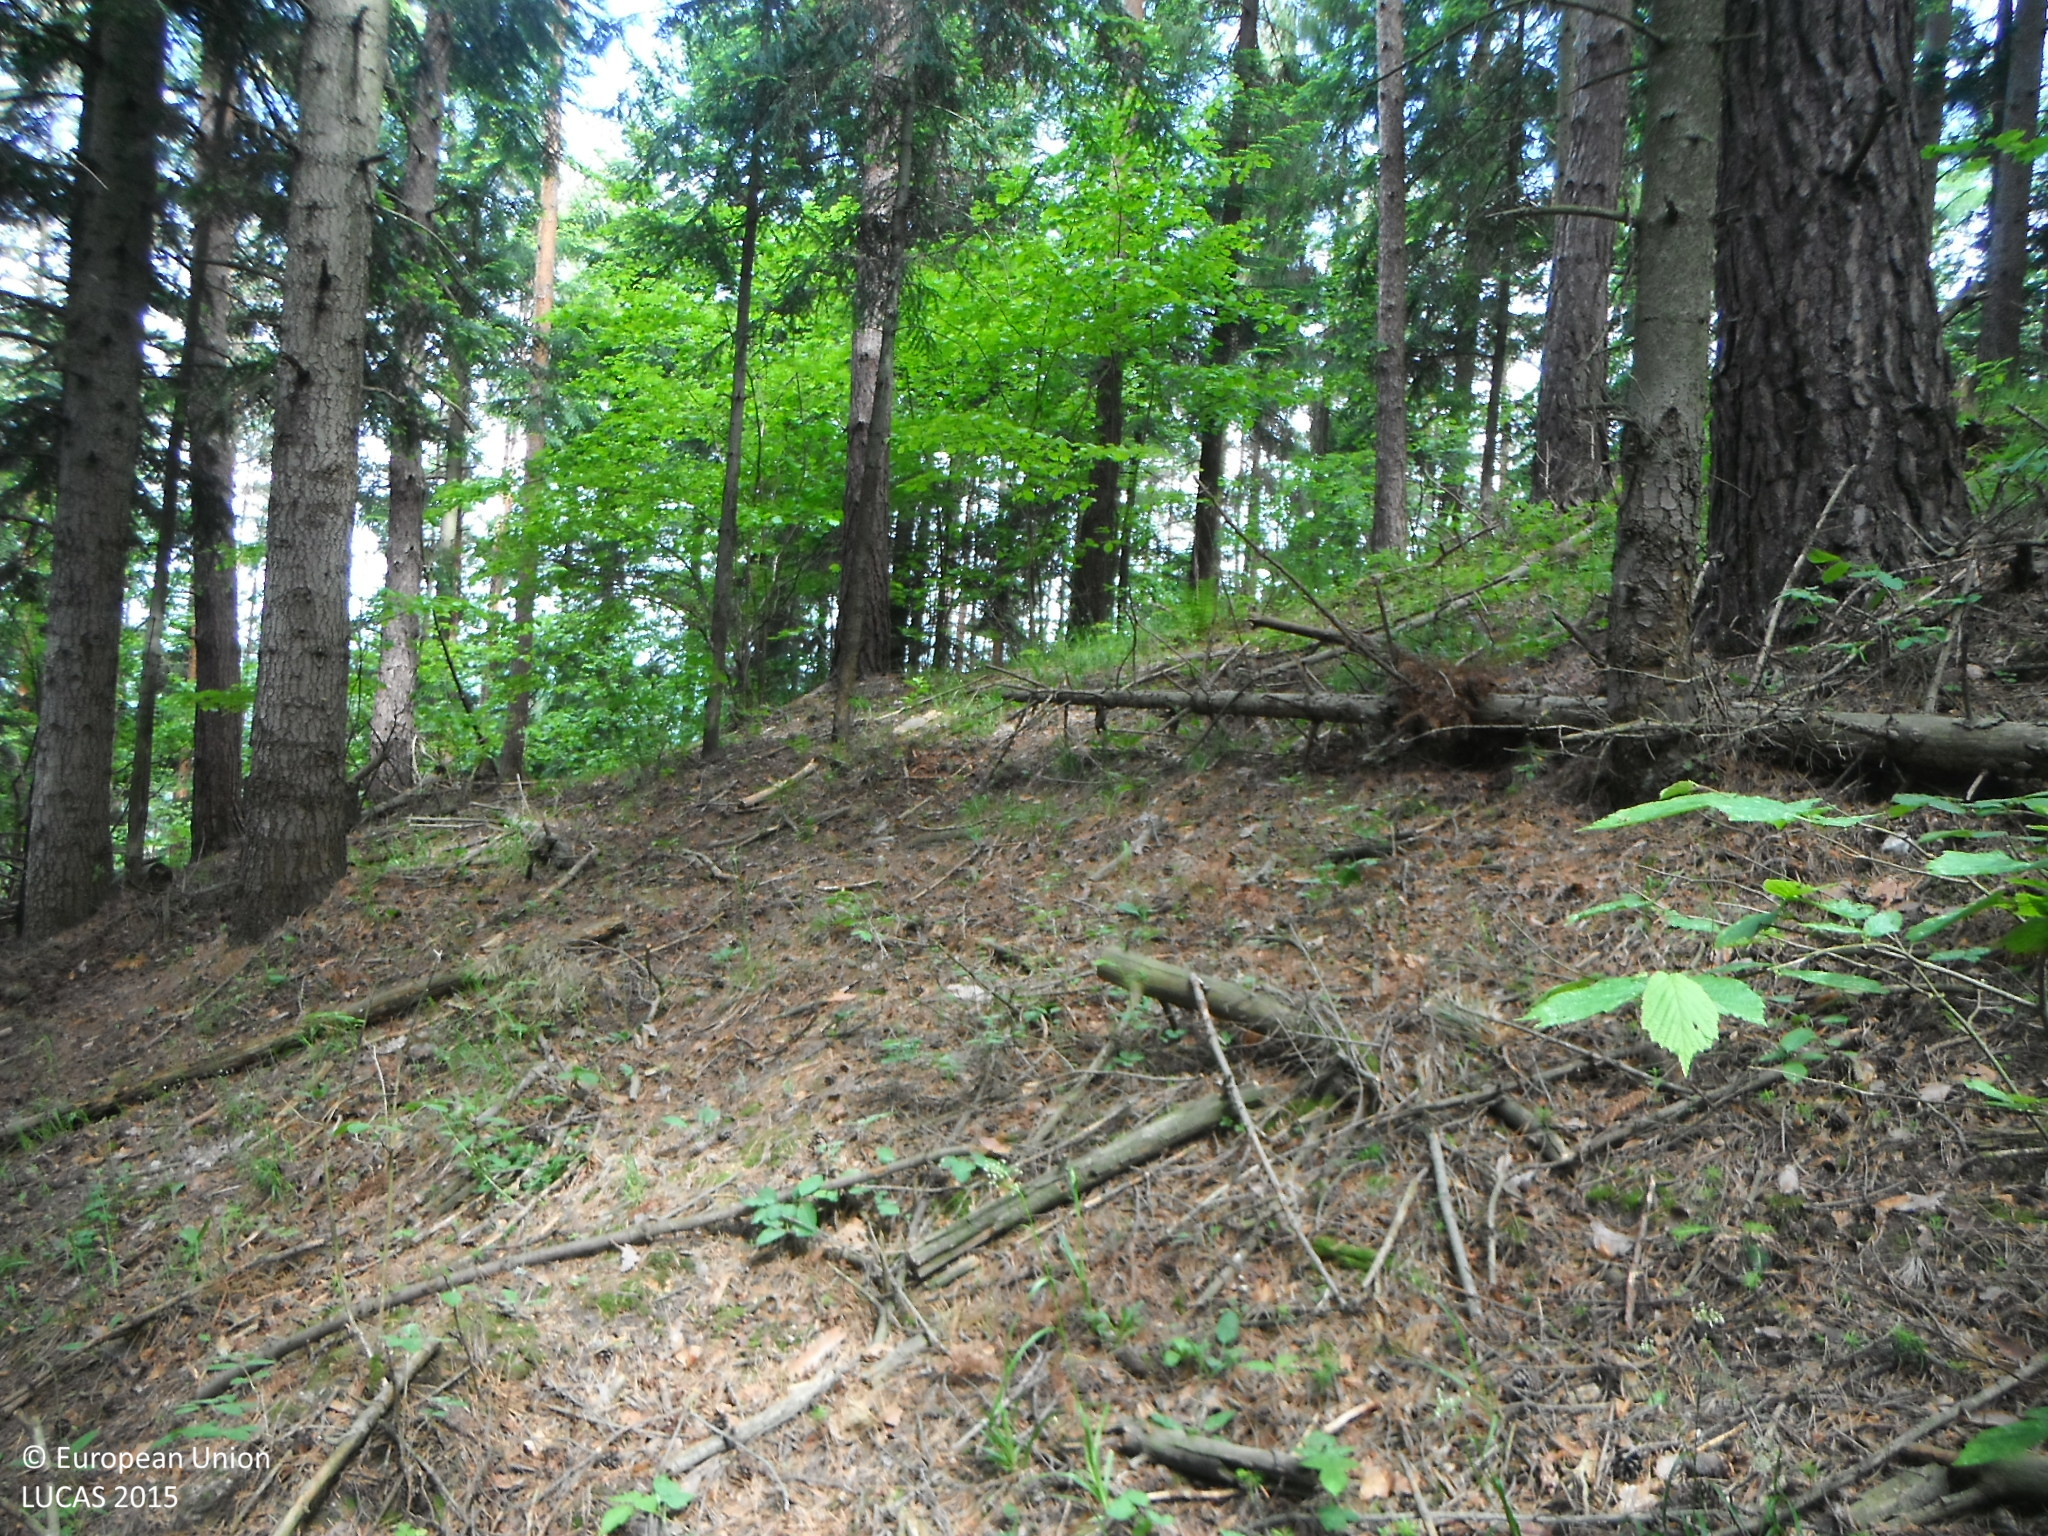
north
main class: Woodland
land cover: Spruce dominated coniferous woodland
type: alpine coniferous forest
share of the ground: > 75 %
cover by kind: coniferous forest trees 100 %
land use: Forestry
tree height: > 5 m
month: May
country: SK
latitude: 48.9906
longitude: 20.8778
